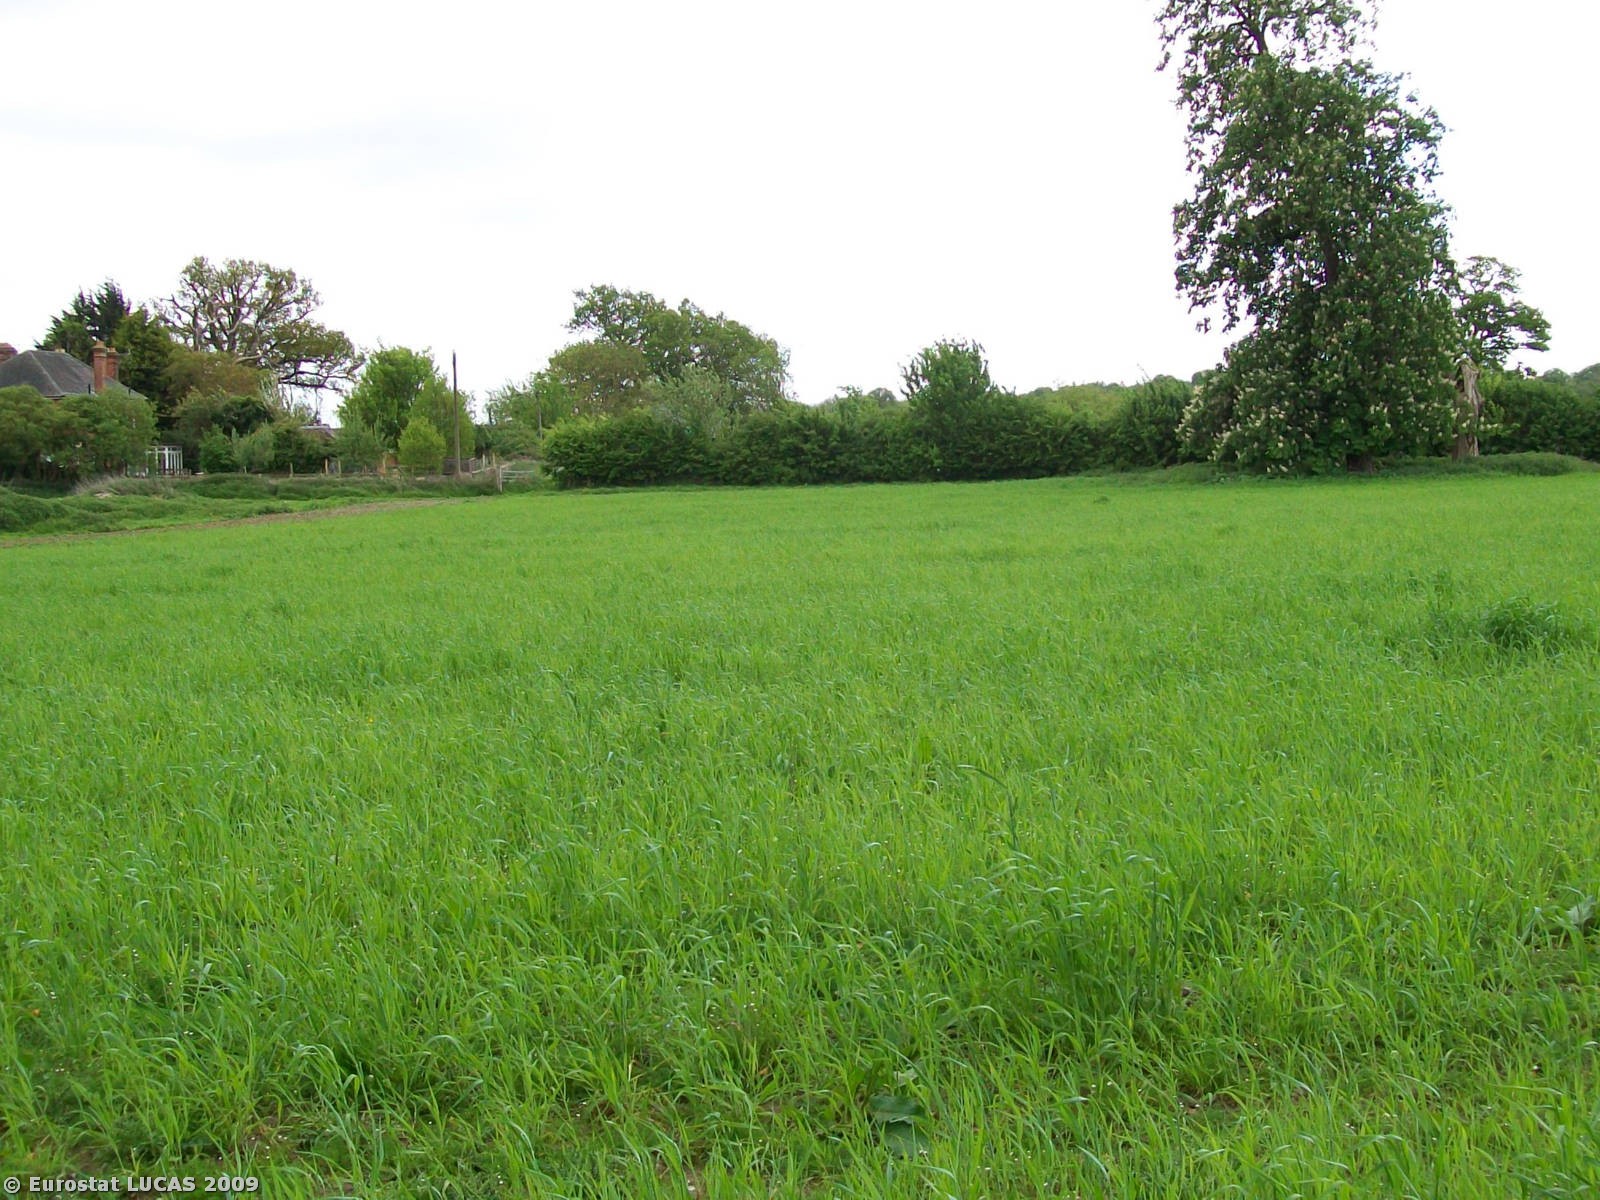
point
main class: Cropland
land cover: Barley
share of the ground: > 75 %
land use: Agriculture (excluding fallow land and kitchen gardens)
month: May
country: GB
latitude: 51.4868
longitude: -0.7706
